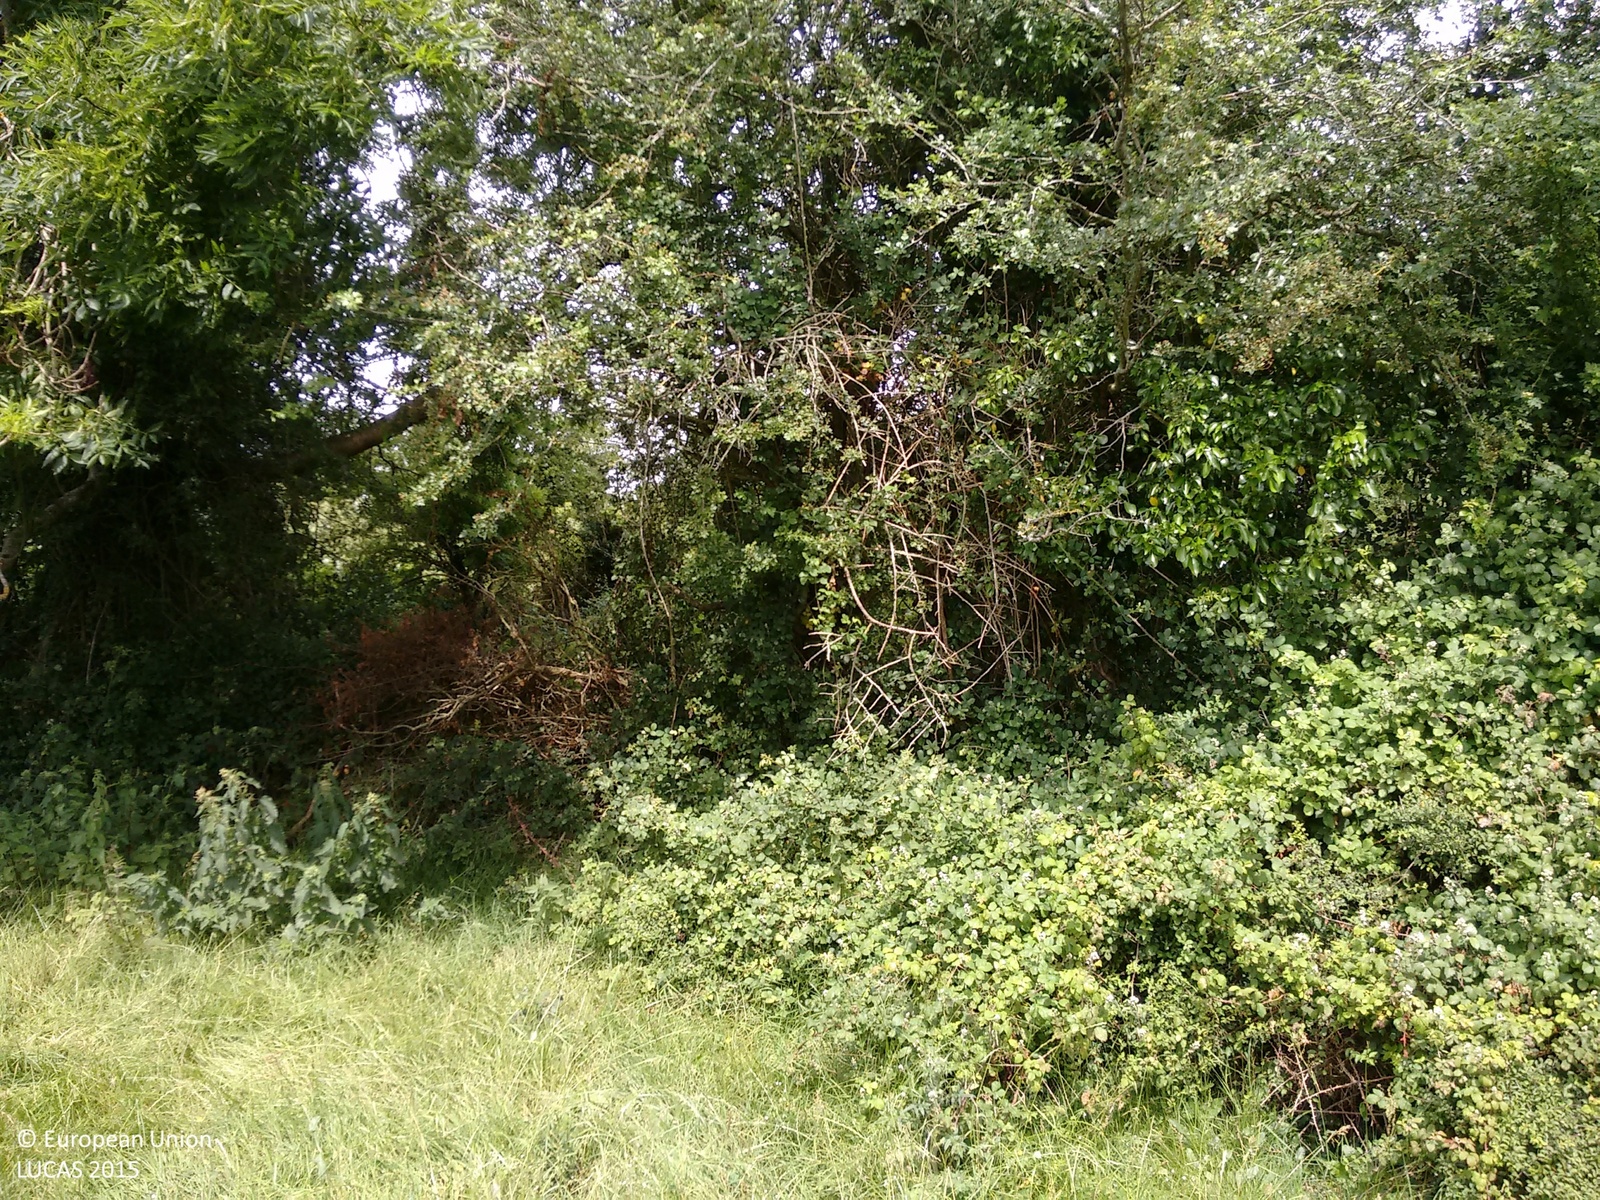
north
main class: Grassland
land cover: Grassland without tree/shrub cover
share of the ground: > 75 %
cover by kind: herbaceous plants 100 %
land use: Agriculture (excluding fallow land and kitchen gardens)
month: July
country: IE
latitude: 53.5497
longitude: -8.0000
